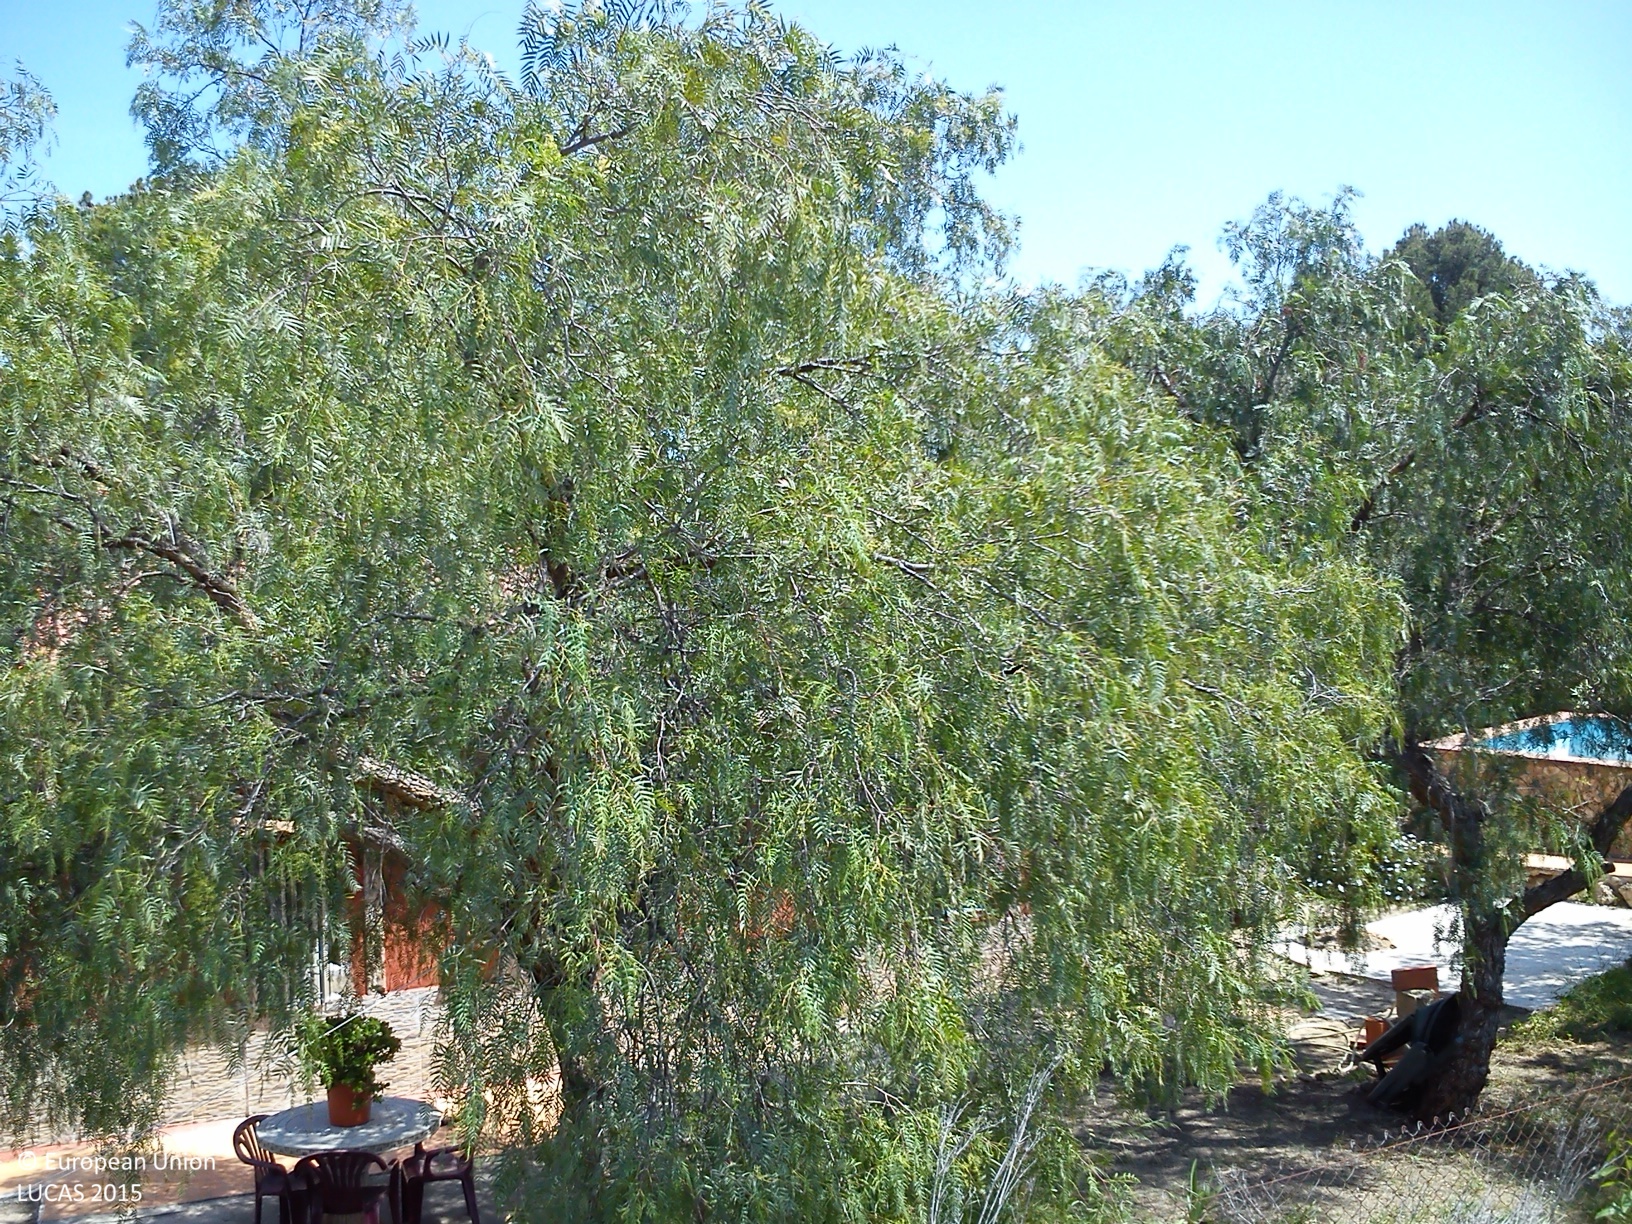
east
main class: Woodland
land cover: Broadleaved woodland
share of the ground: 25 - 50 %
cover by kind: herbaceous plants 50 %, broadleaved forest trees 30 %, consolidated bare surface 20 %
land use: Residential
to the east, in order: Broadleaved woodland; Artificial constructions in urban areas; Shrubland without tree cover; Artificial constructions in urban areas; Shrubland without tree cover; Tracks; Shrubland without tree cover; Oranges
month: April
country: ES
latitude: 39.6454
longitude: -0.6867
